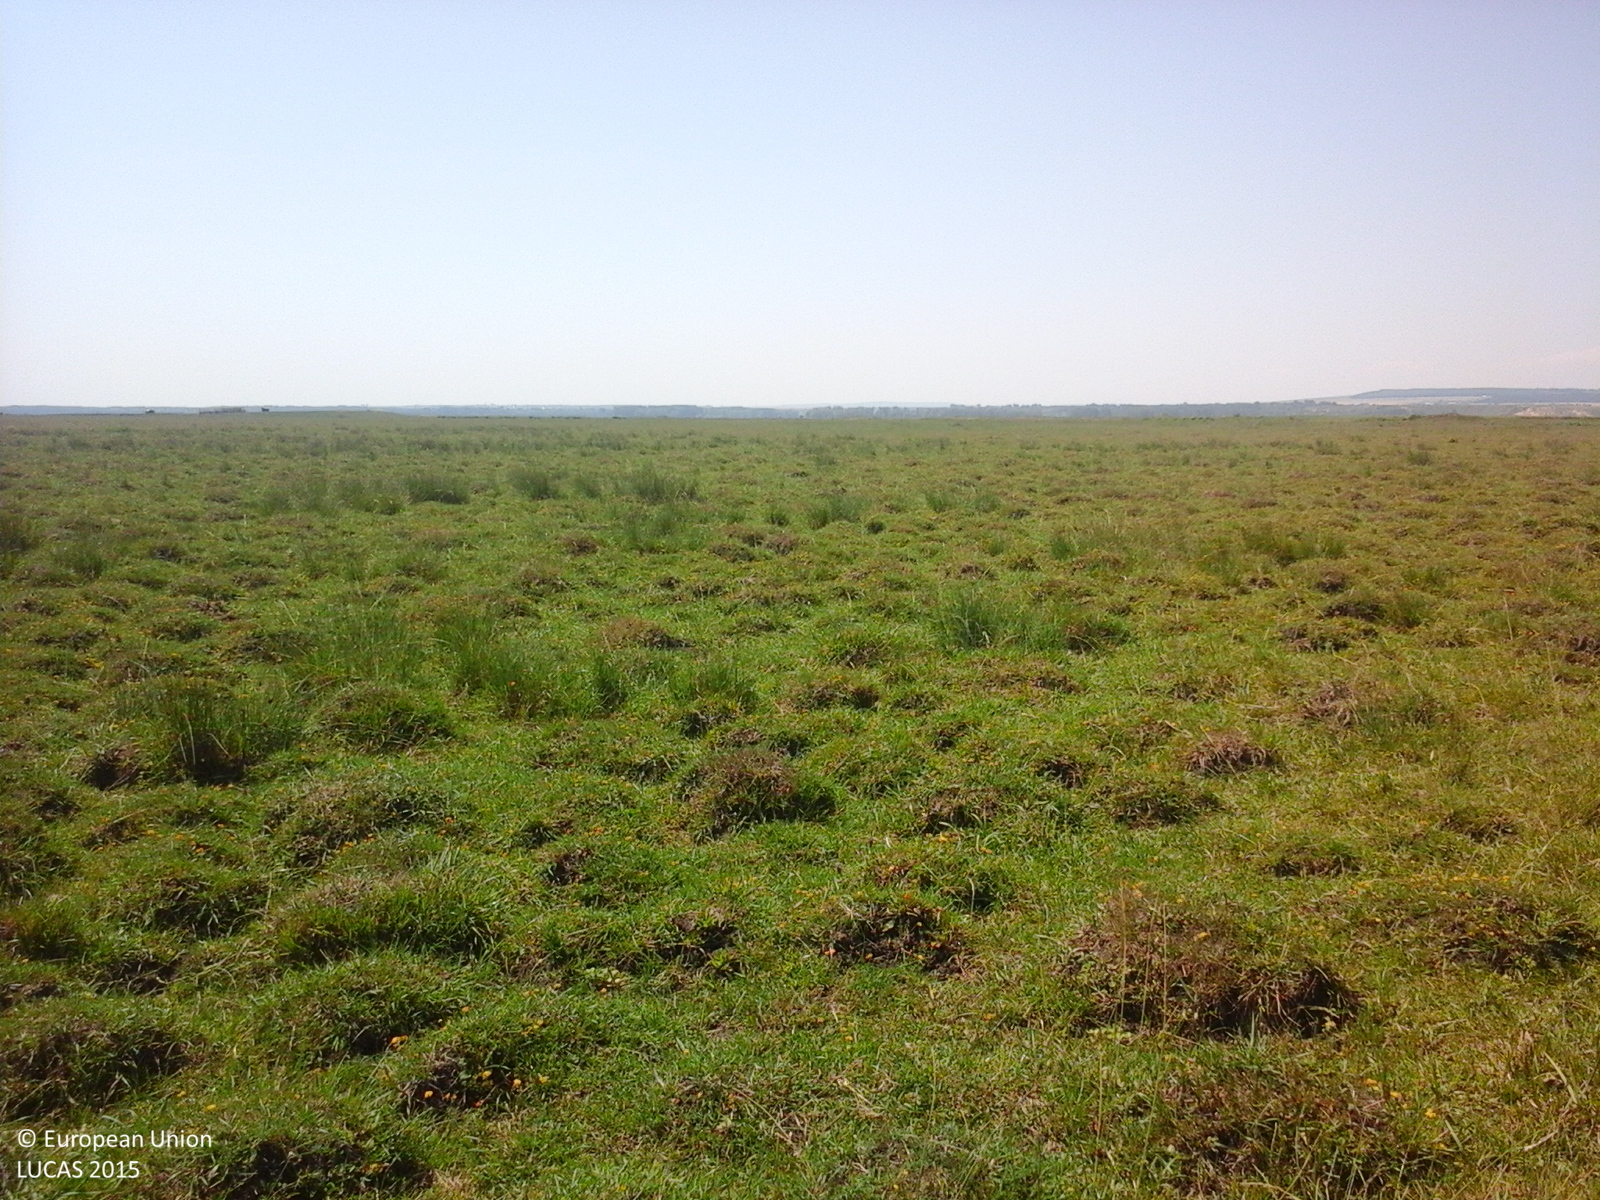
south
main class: Grassland
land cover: Spontaneously vegetated surfaces
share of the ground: > 75 %
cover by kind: herbaceous plants 100 %
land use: Agriculture (excluding fallow land and kitchen gardens)
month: June
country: RO
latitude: 47.1771
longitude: 26.8132
